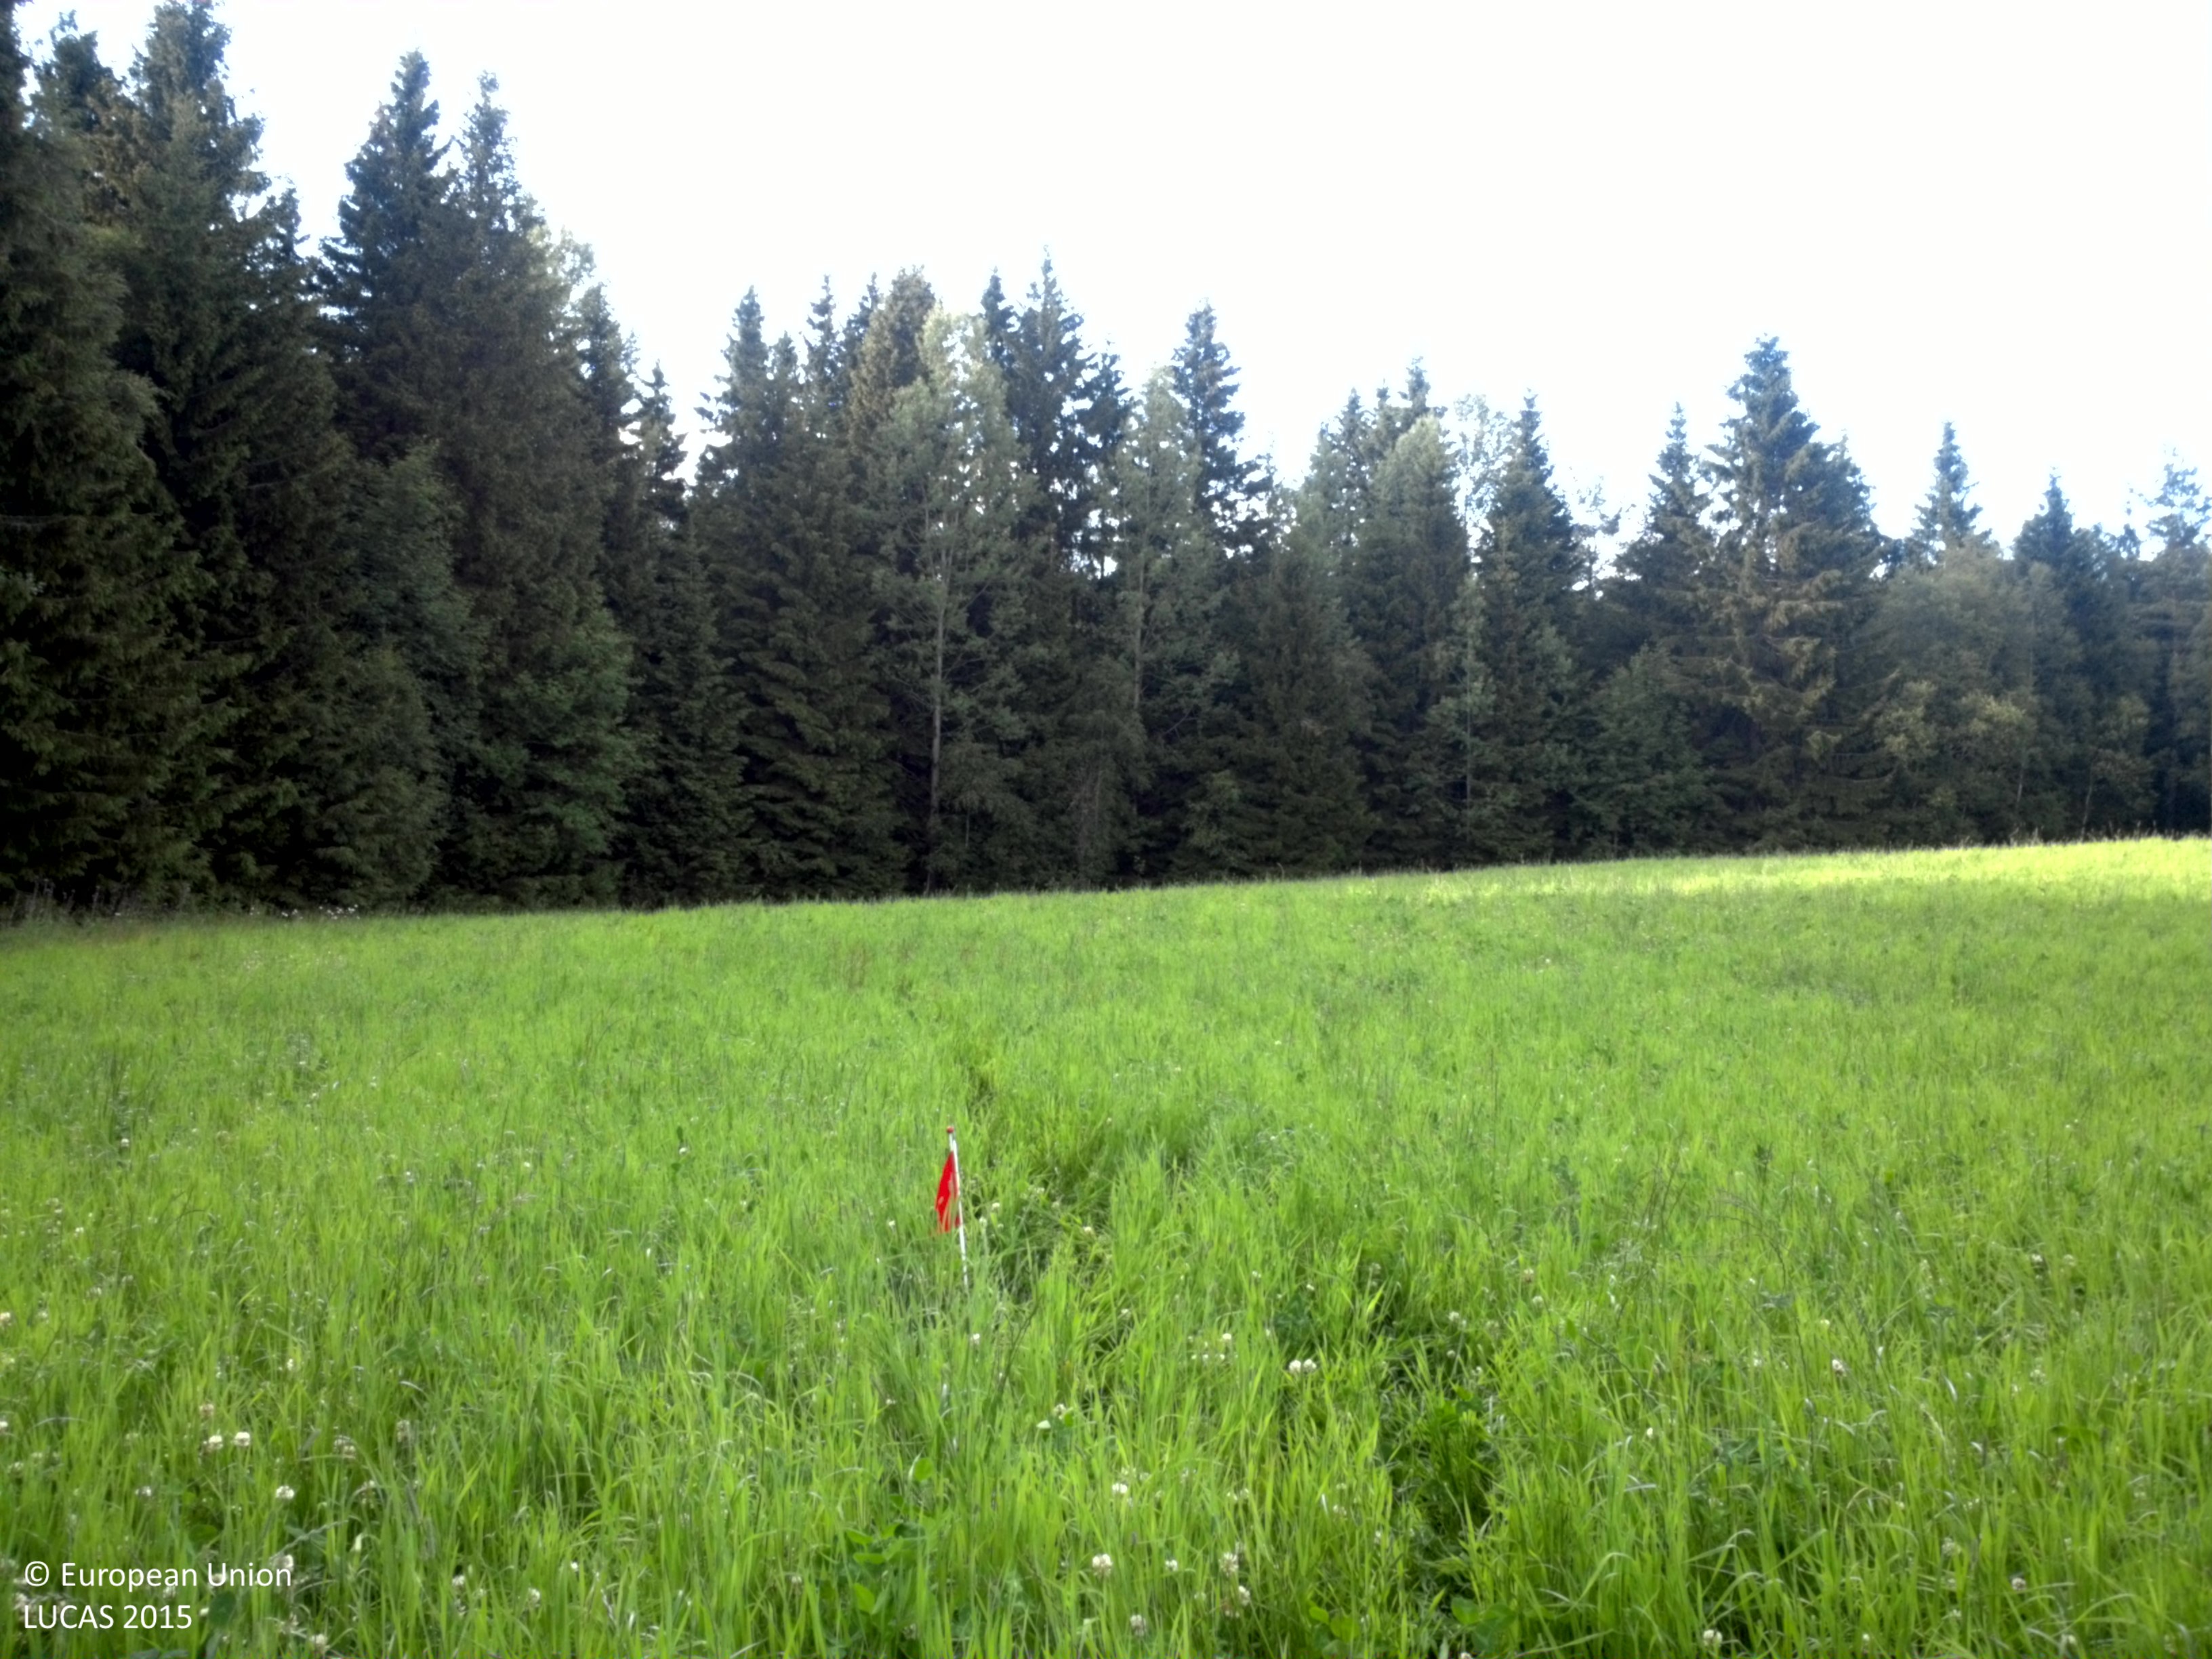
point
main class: Cropland
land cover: Other leguminous and mixtures for fodder
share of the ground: > 75 %
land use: Agriculture (excluding fallow land and kitchen gardens)
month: July
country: SE
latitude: 57.6027
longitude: 14.5305
